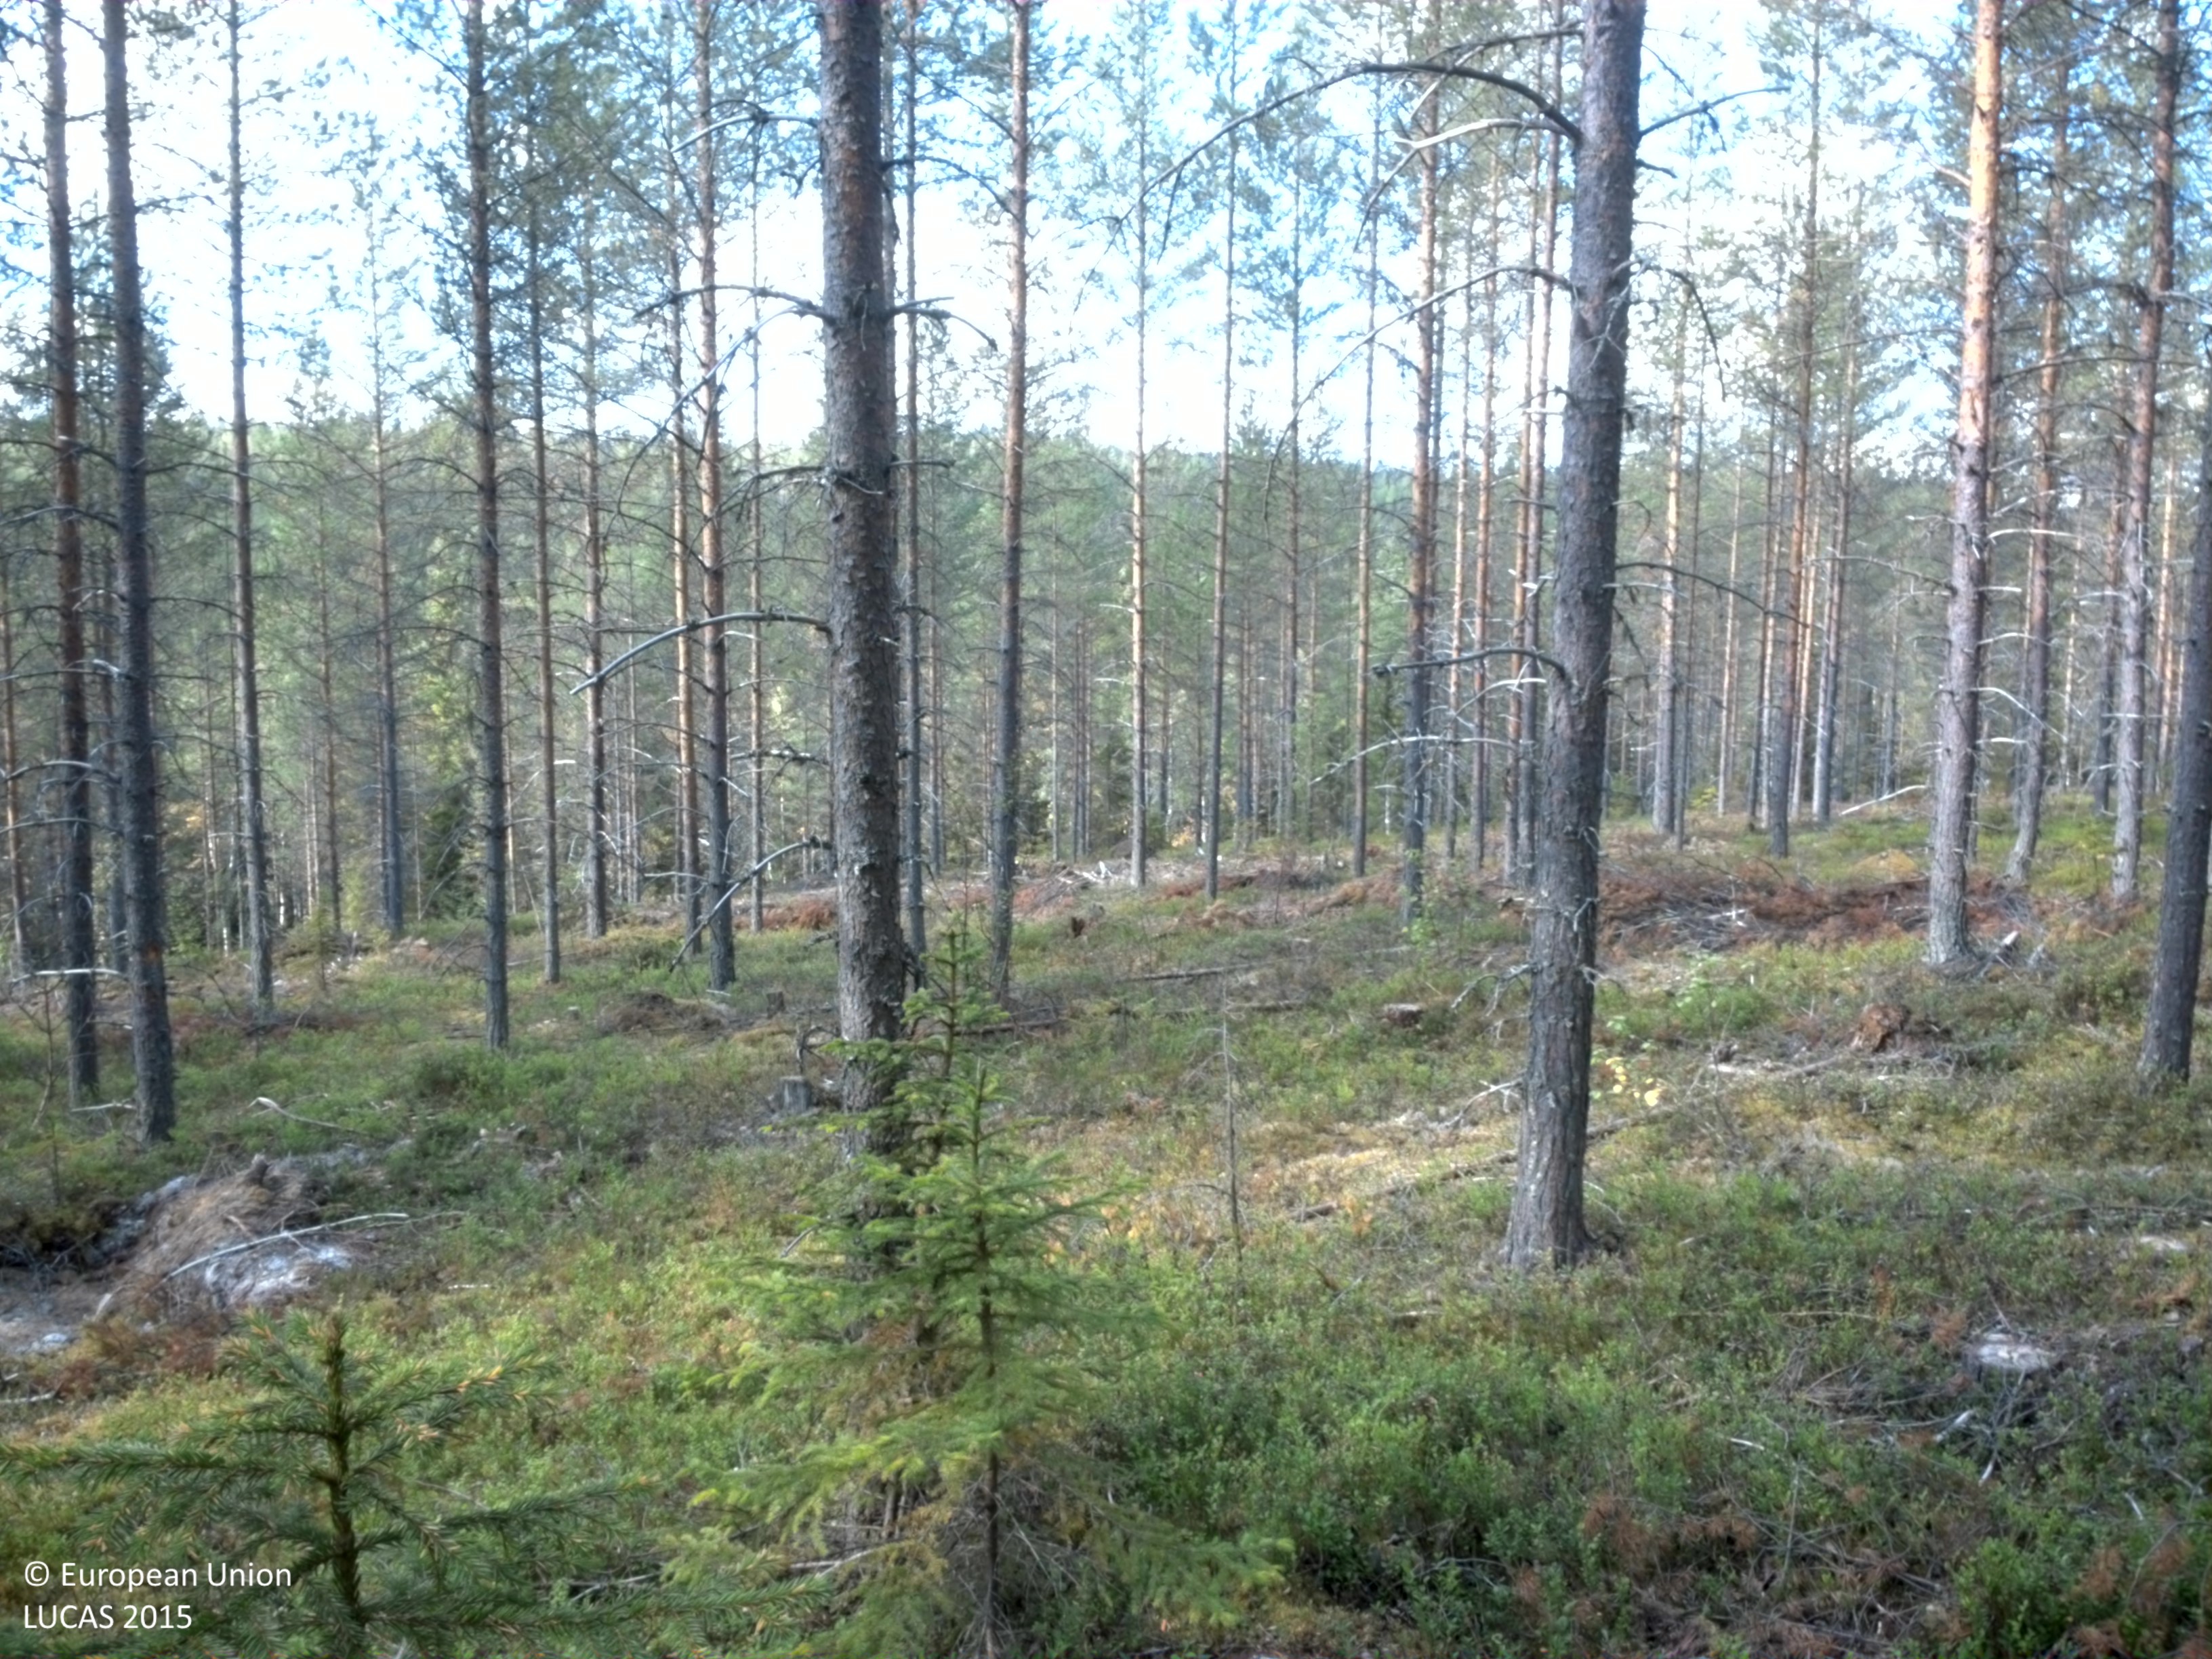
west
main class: Woodland
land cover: Pine dominated coniferous woodland
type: boreal forest
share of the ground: 50 - 75 %
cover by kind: coniferous forest trees 55 %, shrubs 40 %, lichens and mosses 5 %
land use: Forestry
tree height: > 5 m
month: August
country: SE
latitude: 64.5964
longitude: 19.0152
